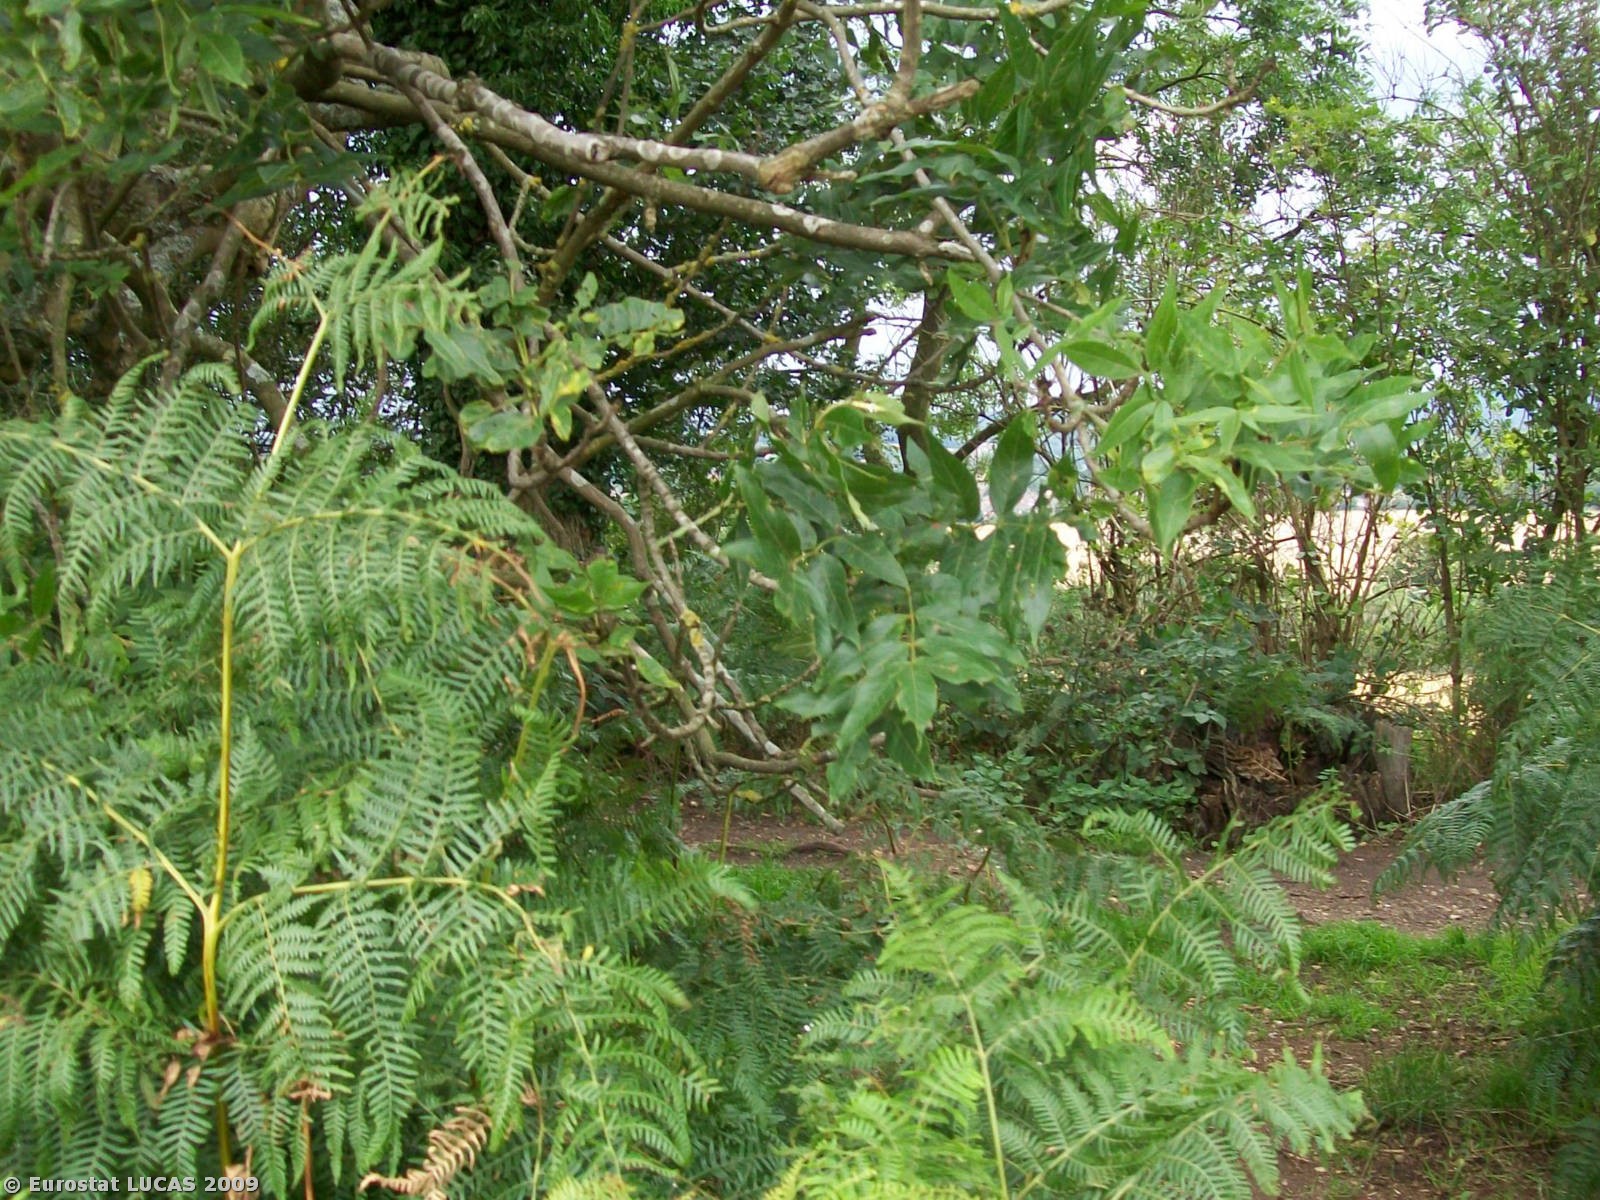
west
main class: Cropland
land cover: Barley
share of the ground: > 75 %
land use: Agriculture (excluding fallow land and kitchen gardens)
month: August
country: GB
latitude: 51.4777
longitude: -1.0601
